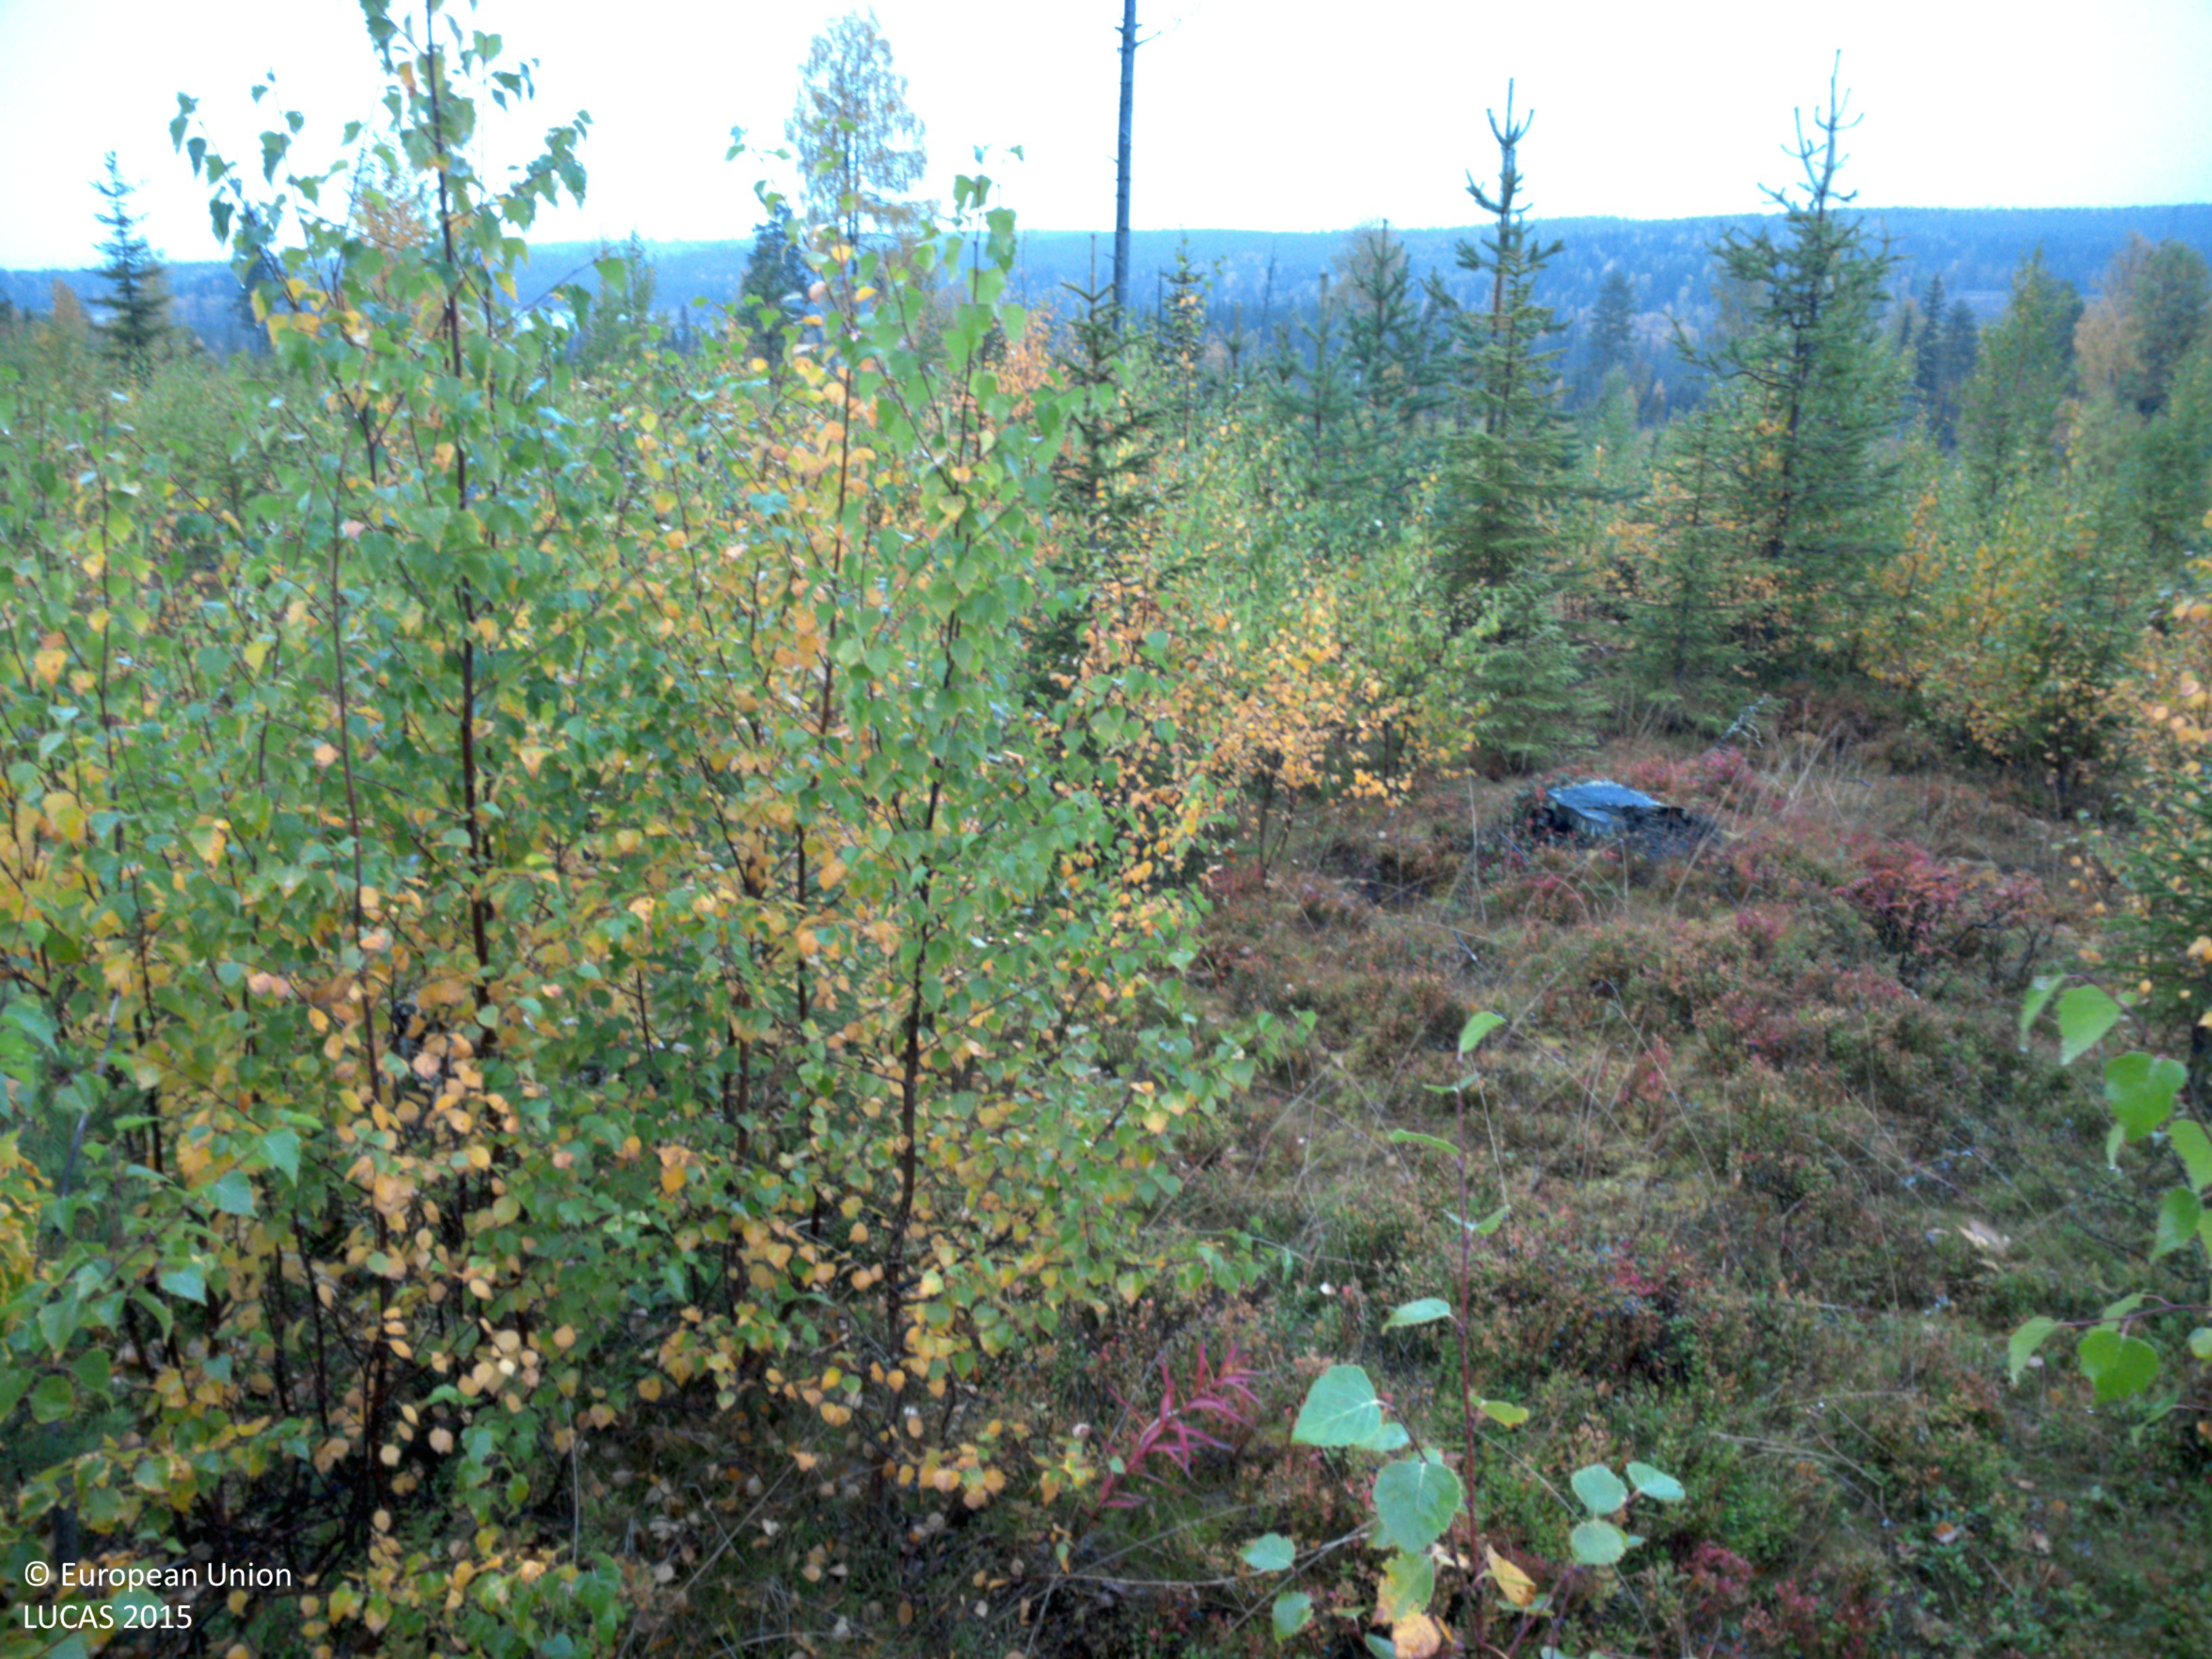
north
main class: Woodland
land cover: Spruce dominated mixed woodland
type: boreal forest
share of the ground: 50 - 75 %
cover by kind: coniferous forest trees 40 %, broadleaved forest trees 30 %, shrubs 25 %, herbaceous plants 5 %
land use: Forestry
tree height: < 5 m
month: September
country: SE
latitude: 64.9134
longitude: 19.2042
